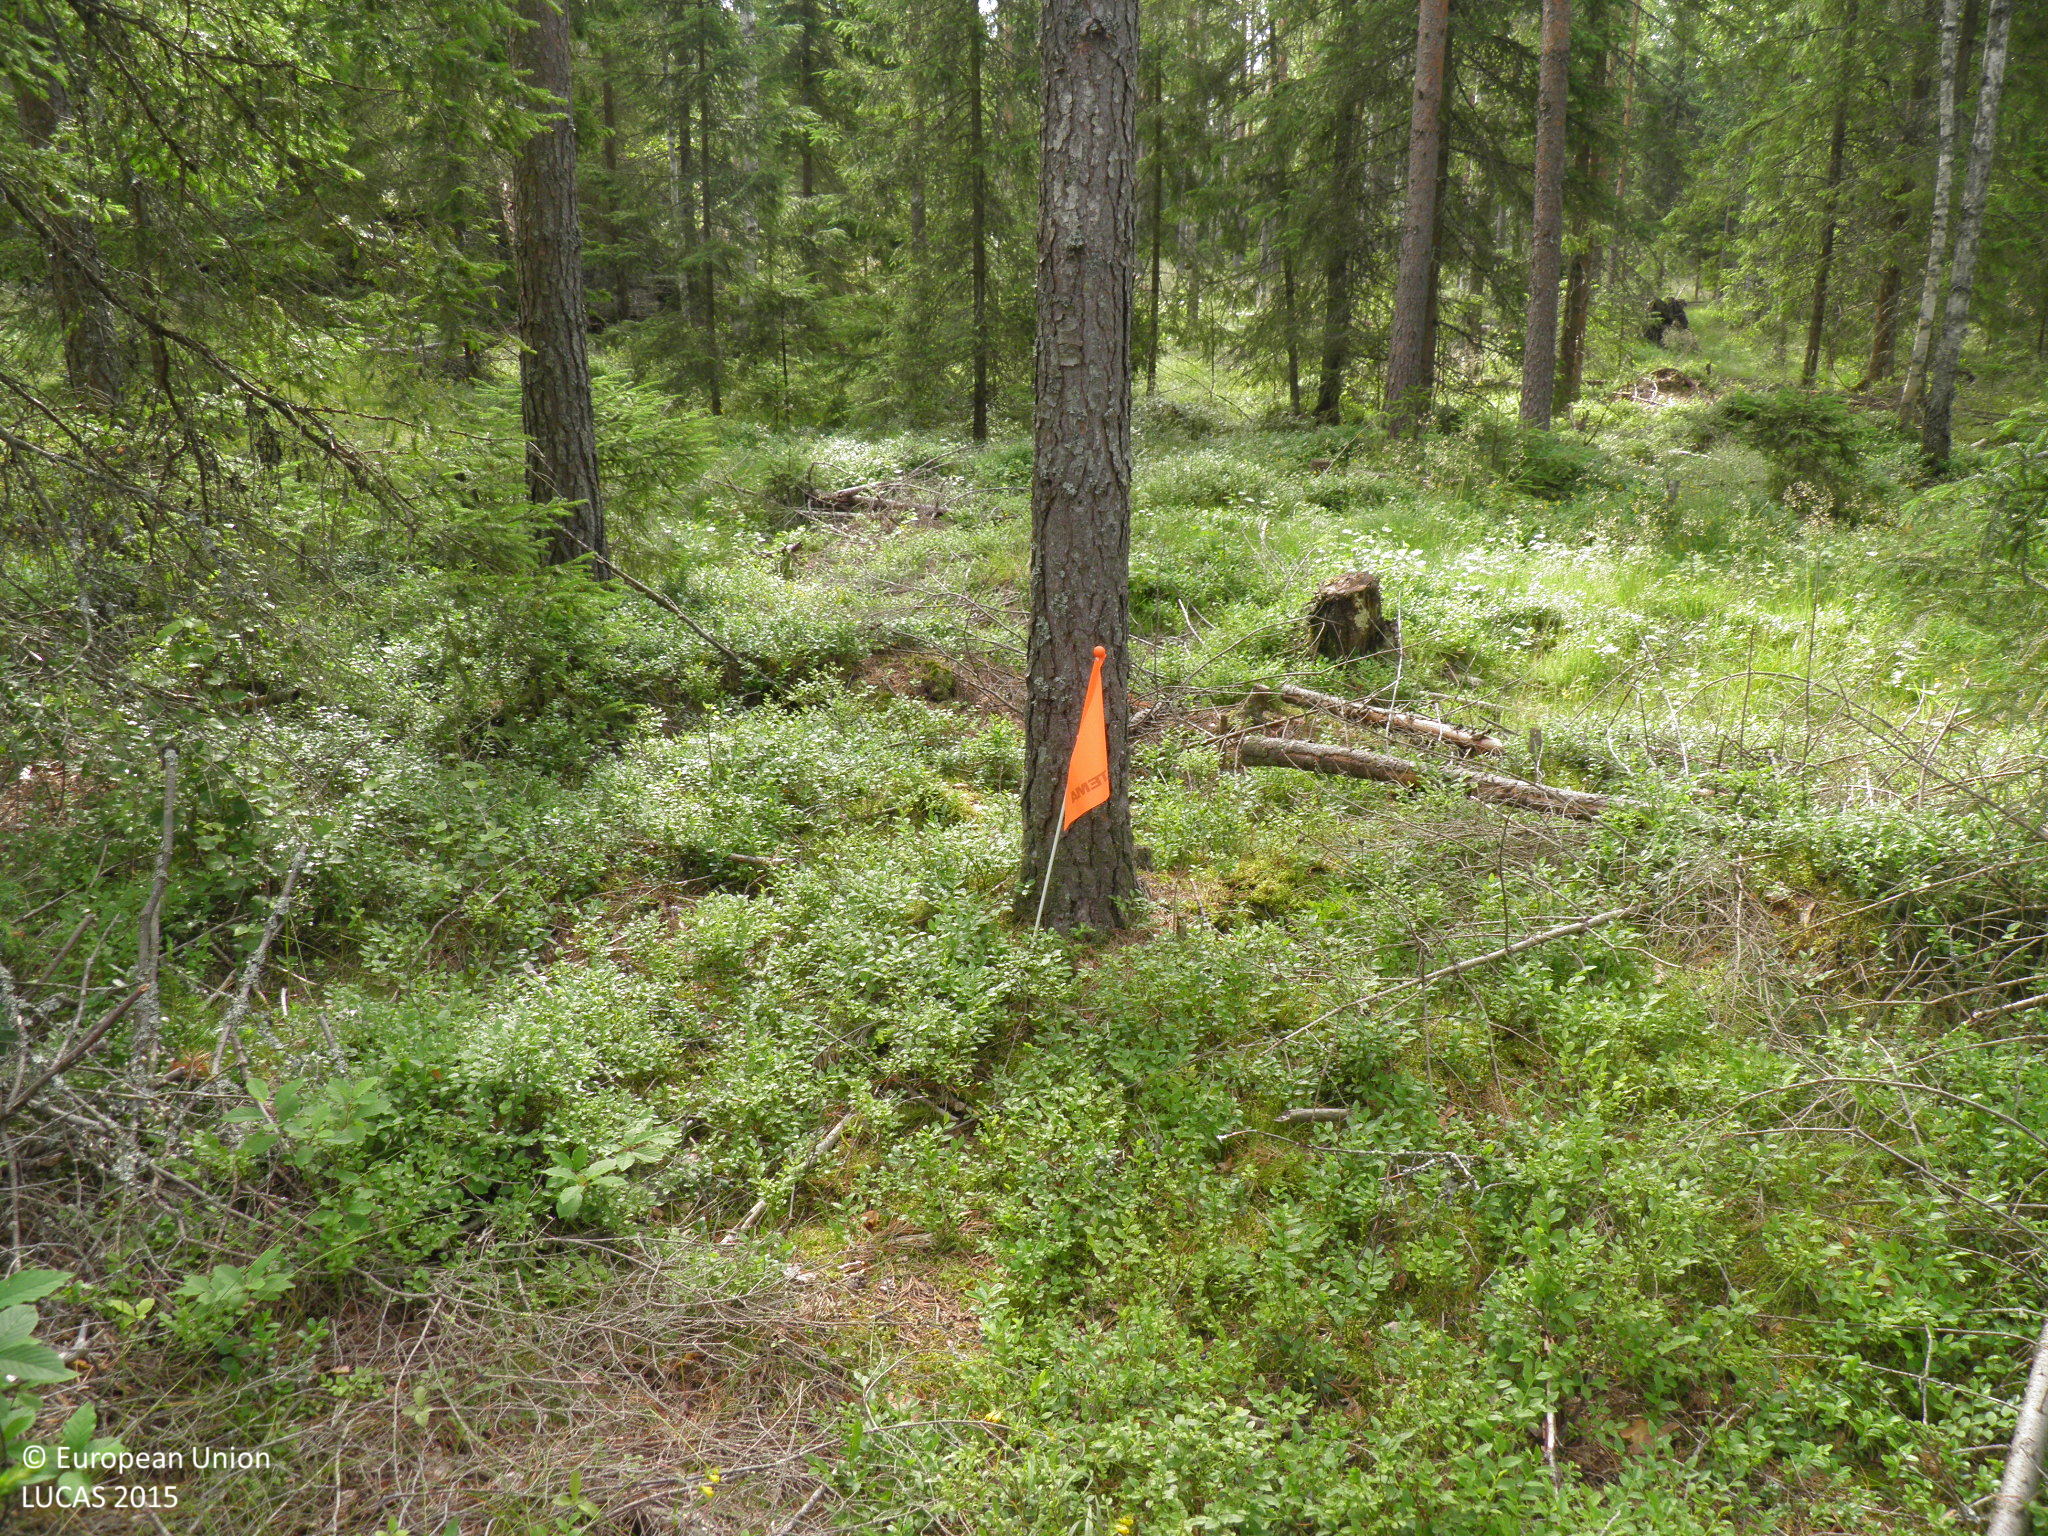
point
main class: Woodland
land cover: Pine dominated coniferous woodland
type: hemiboreal forest and nemoral coniferous forest and mixed broadleaved-coniferous forest
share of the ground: 50 - 75 %
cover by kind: coniferous forest trees 45 %, shrubs 20 %, lichens and mosses 15 %, broadleaved forest trees 10 %, herbaceous plants 10 %
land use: Forestry
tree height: > 5 m
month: July
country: FI
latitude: 60.8145
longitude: 22.4396
